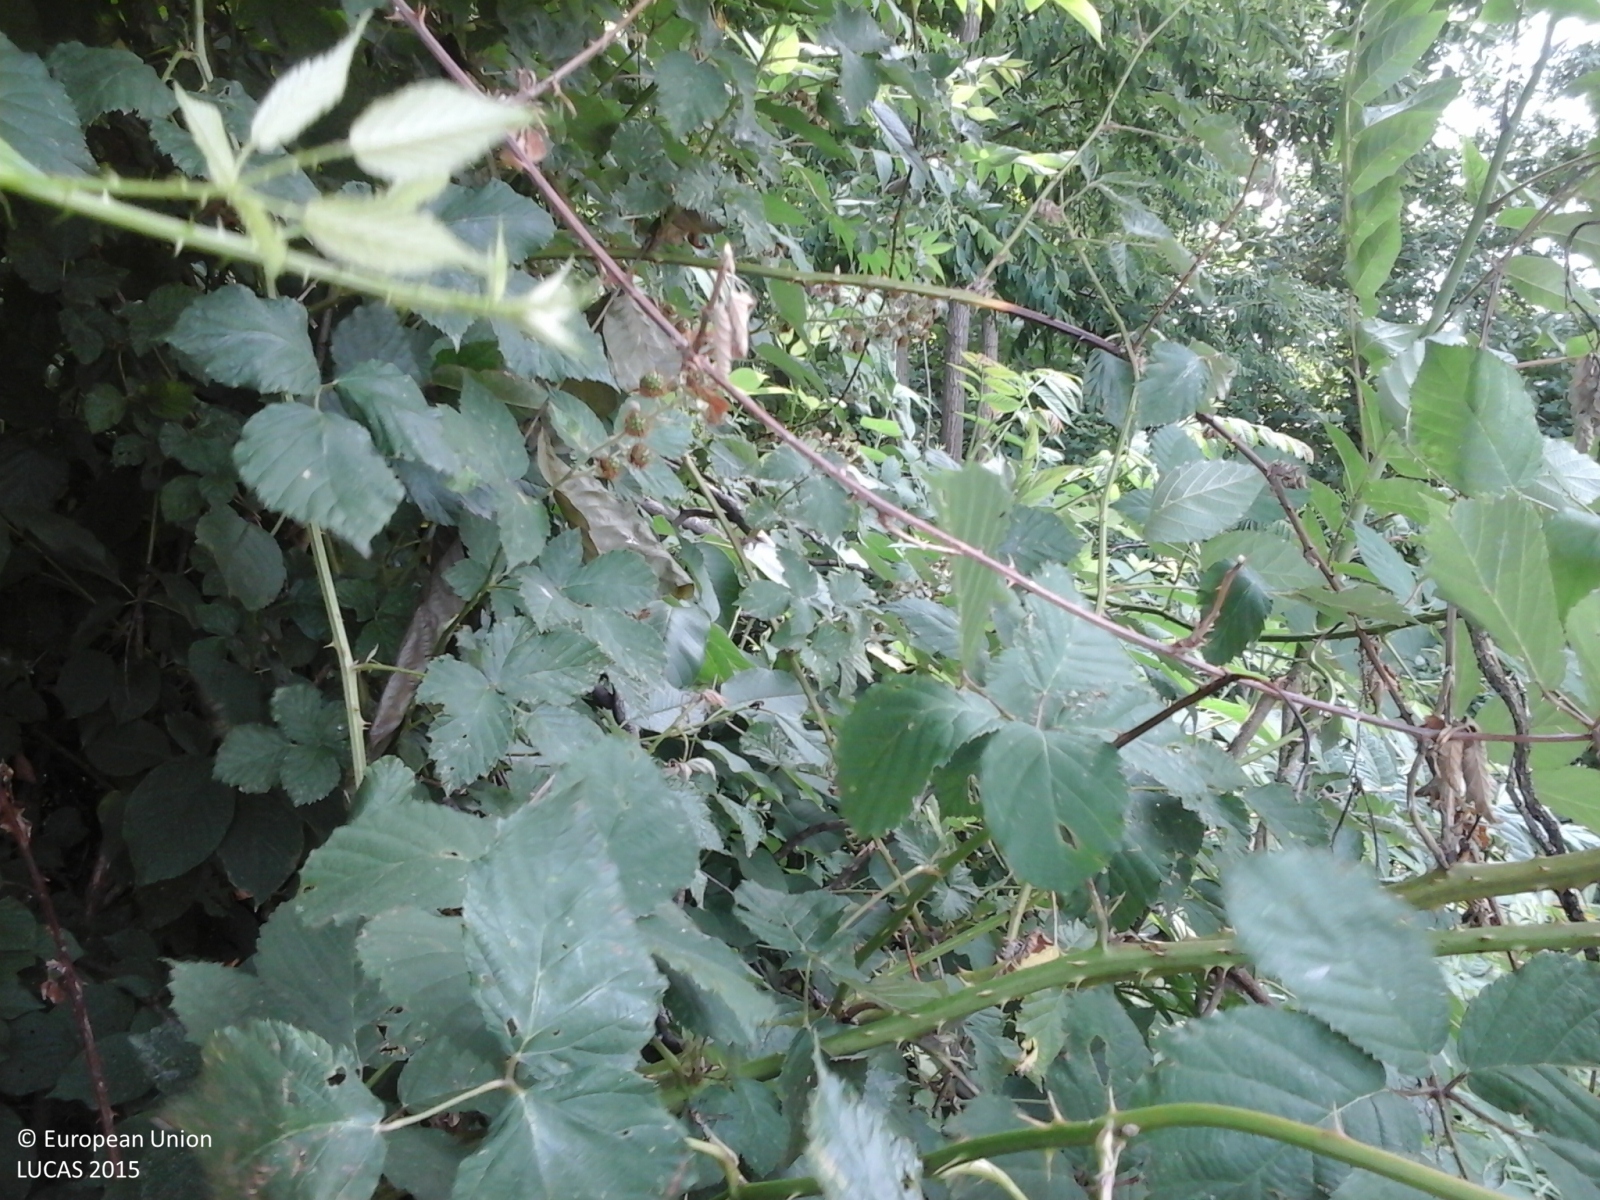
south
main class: Woodland
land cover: Broadleaved woodland
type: thermophilous deciduous forest
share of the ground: > 75 %
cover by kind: broadleaved forest trees 100 %
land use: Forestry
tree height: > 5 m
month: June
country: IT
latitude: 45.4927
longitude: 8.4287
